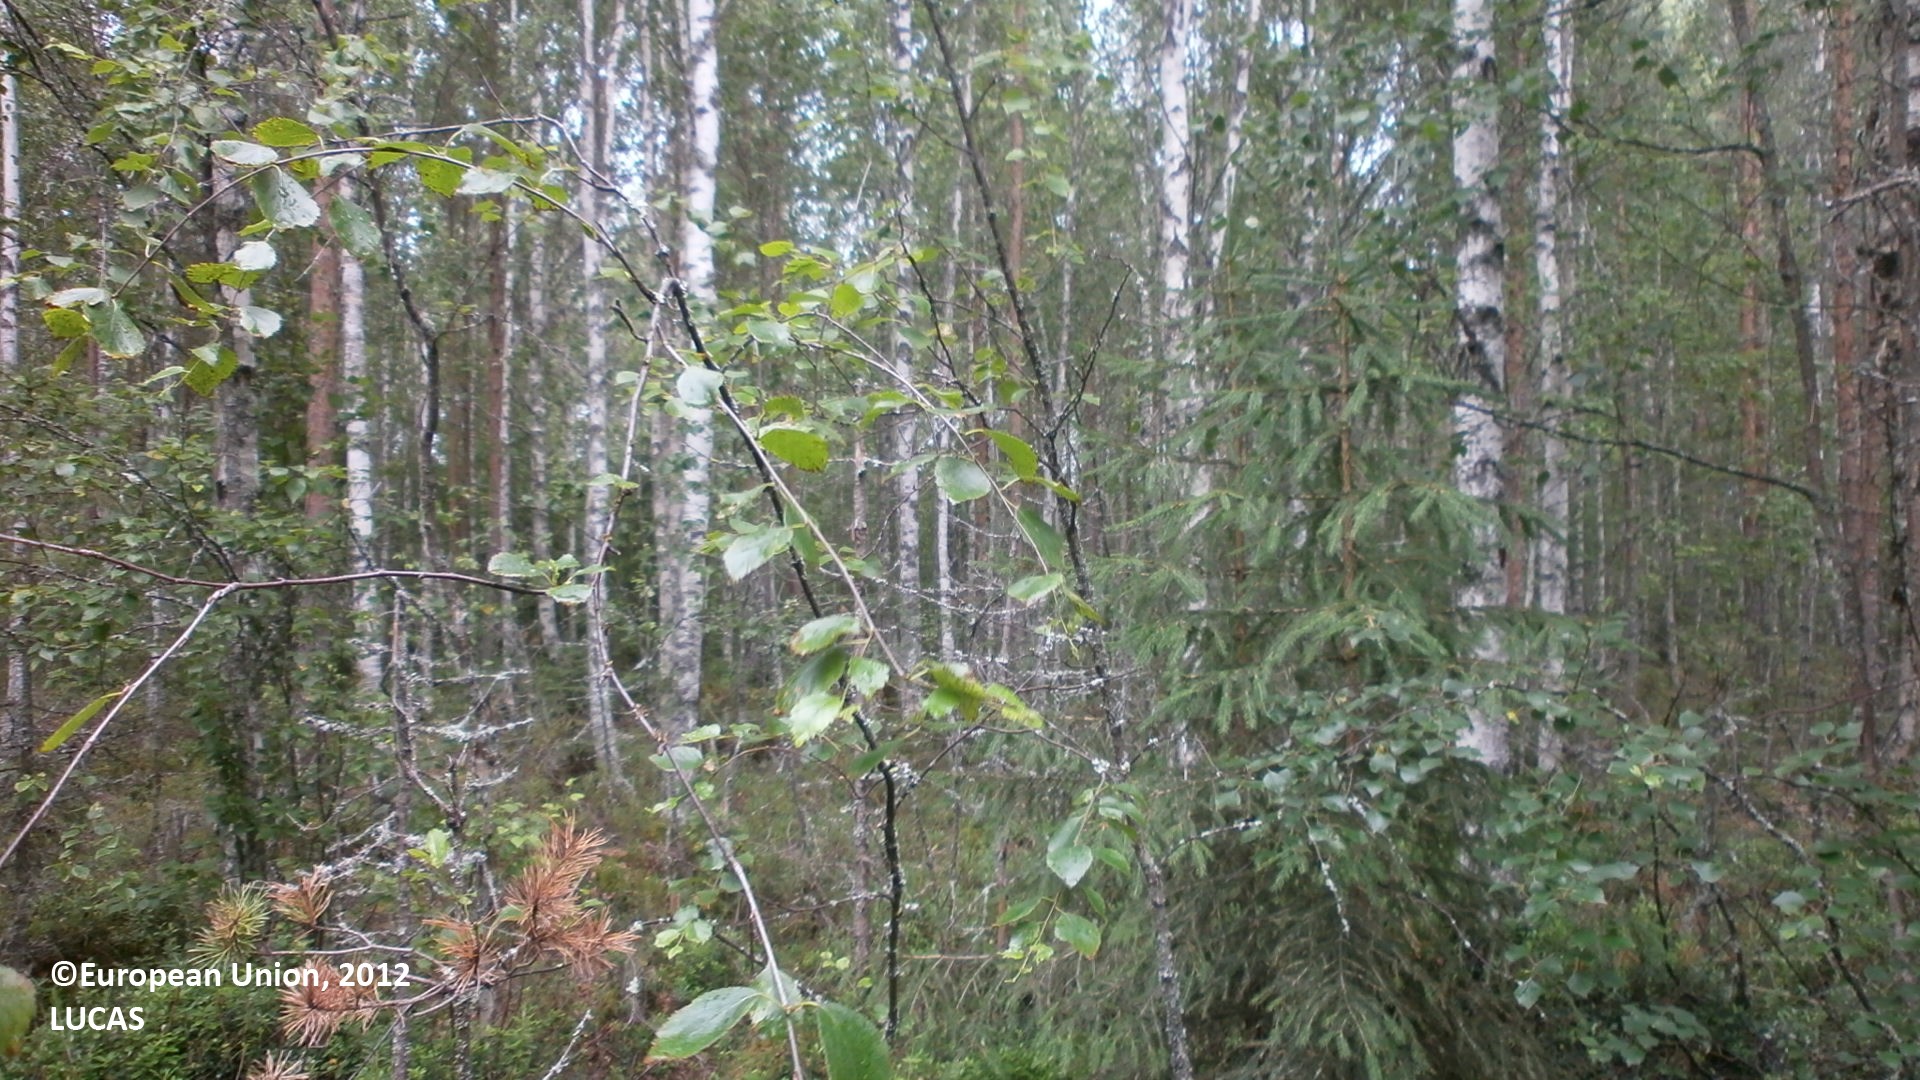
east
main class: Woodland
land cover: Pine dominated mixed woodland
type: boreal forest
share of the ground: 50 - 75 %
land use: Forestry
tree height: > 5 m
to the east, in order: Pine dominated mixed woodland; Ditches and canals; Pine dominated mixed woodland; Ditches and canals; Pine dominated mixed woodland; Ditches and canals; Broadleaved woodland; Ditches and canals; Broadleaved woodland; Ditches and canals; Broadleaved woodland; Ditches and canals; Broadleaved woodland; Ditches and canals; Broadleaved woodland; Pine dominated mixed woodland; Broadleaved woodland; Ditches and canals; Broadleaved woodland; Ditches and canals; Pine dominated mixed woodland
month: July
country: FI
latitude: 64.2694
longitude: 24.4183
